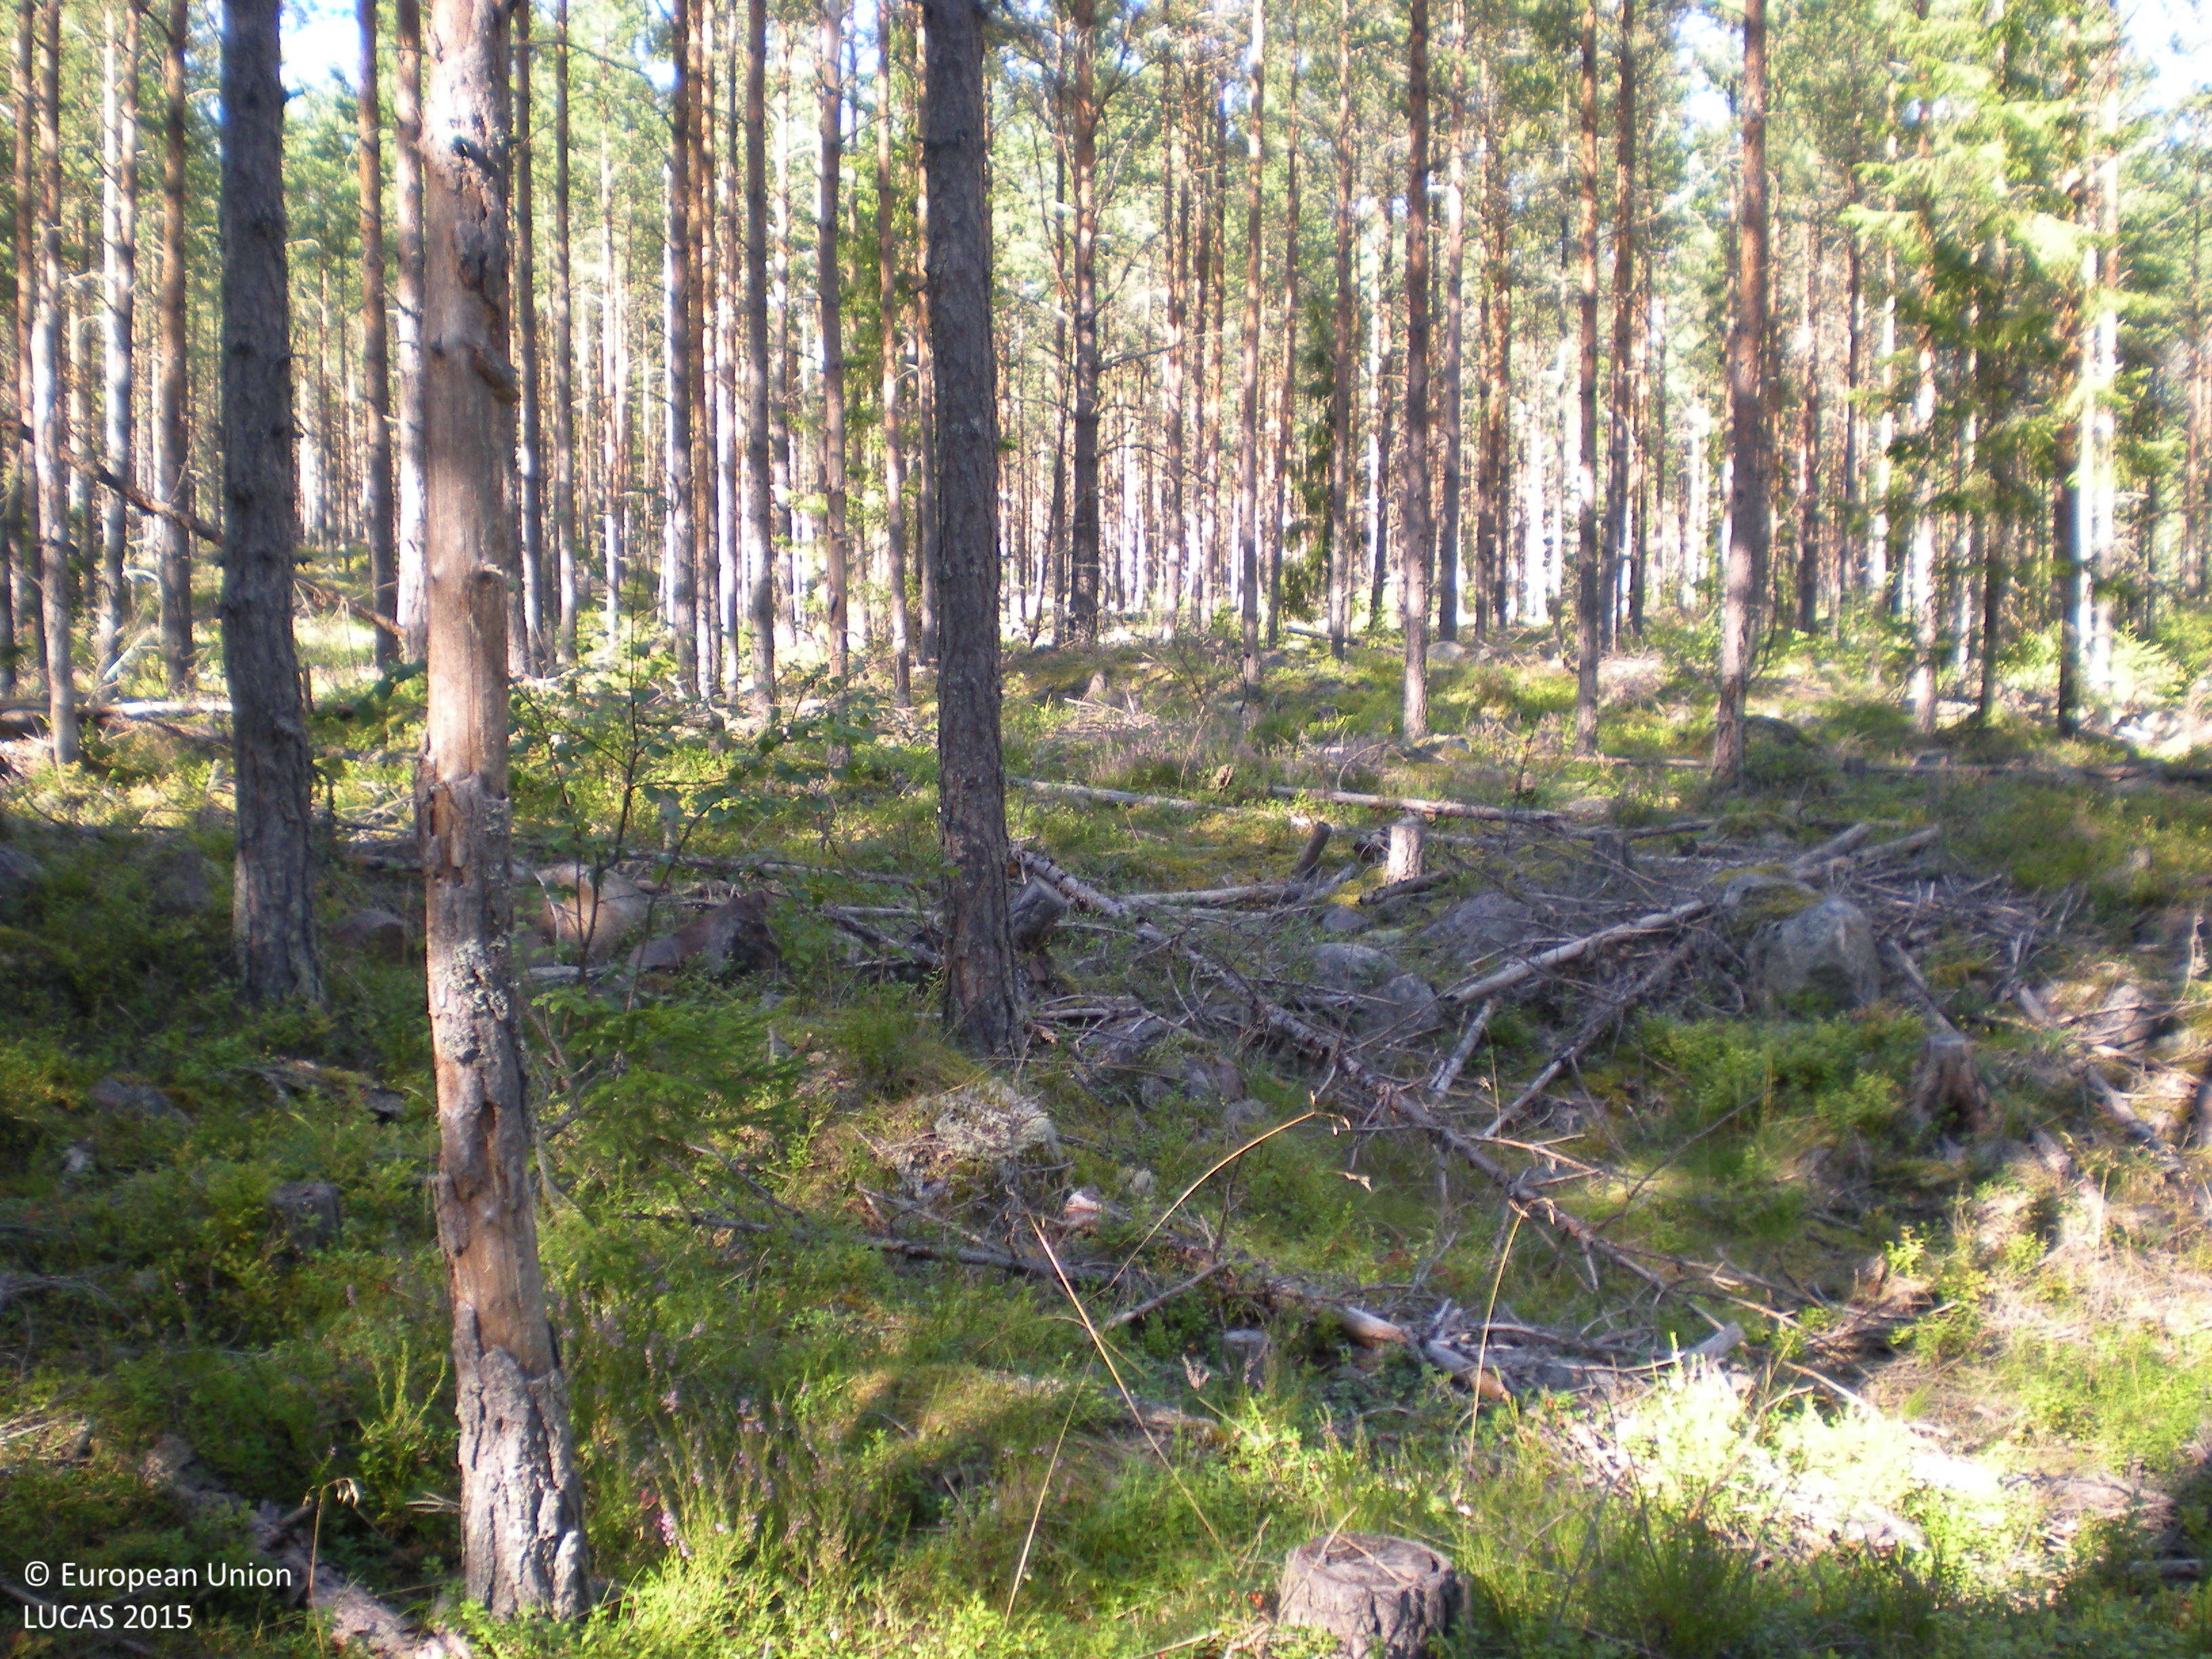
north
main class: Woodland
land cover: Pine dominated coniferous woodland
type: boreal forest
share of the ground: 50 - 75 %
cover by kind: coniferous forest trees 65 %, shrubs 15 %, lichens and mosses 10 %, broadleaved forest trees 5 %
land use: Forestry
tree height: > 5 m
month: August
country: SE
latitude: 60.5415
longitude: 16.7882
